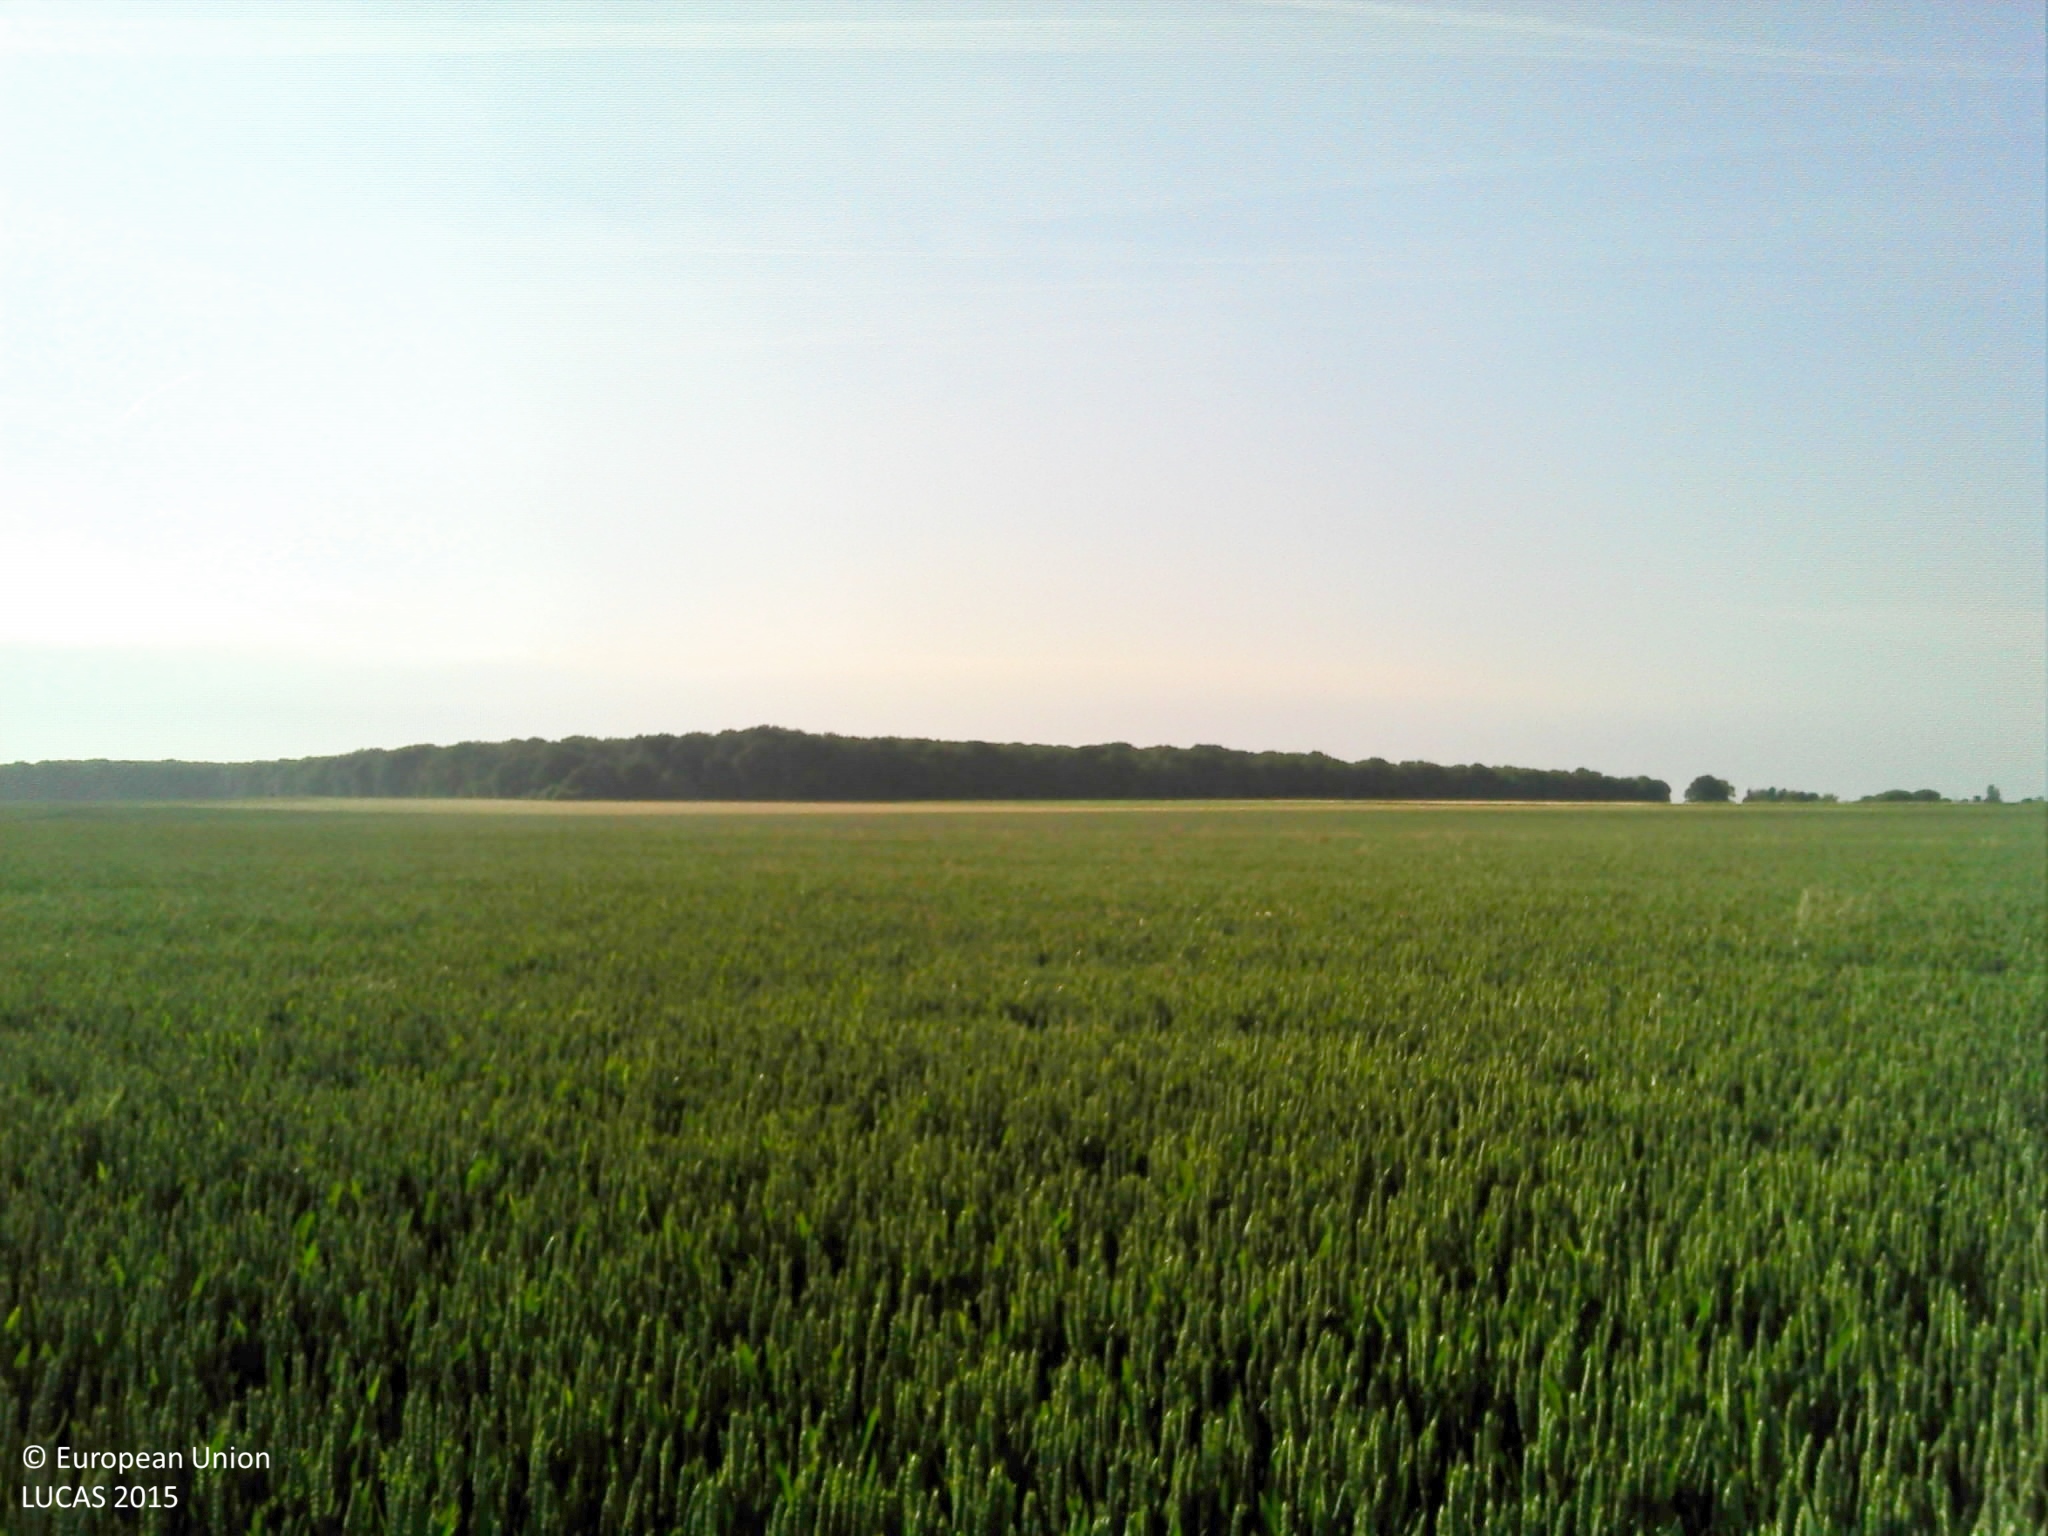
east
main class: Cropland
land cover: Common wheat
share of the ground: > 75 %
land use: Agriculture (excluding fallow land and kitchen gardens)
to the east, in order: Common wheat
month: June
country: FR
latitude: 49.4350
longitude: 2.5557
